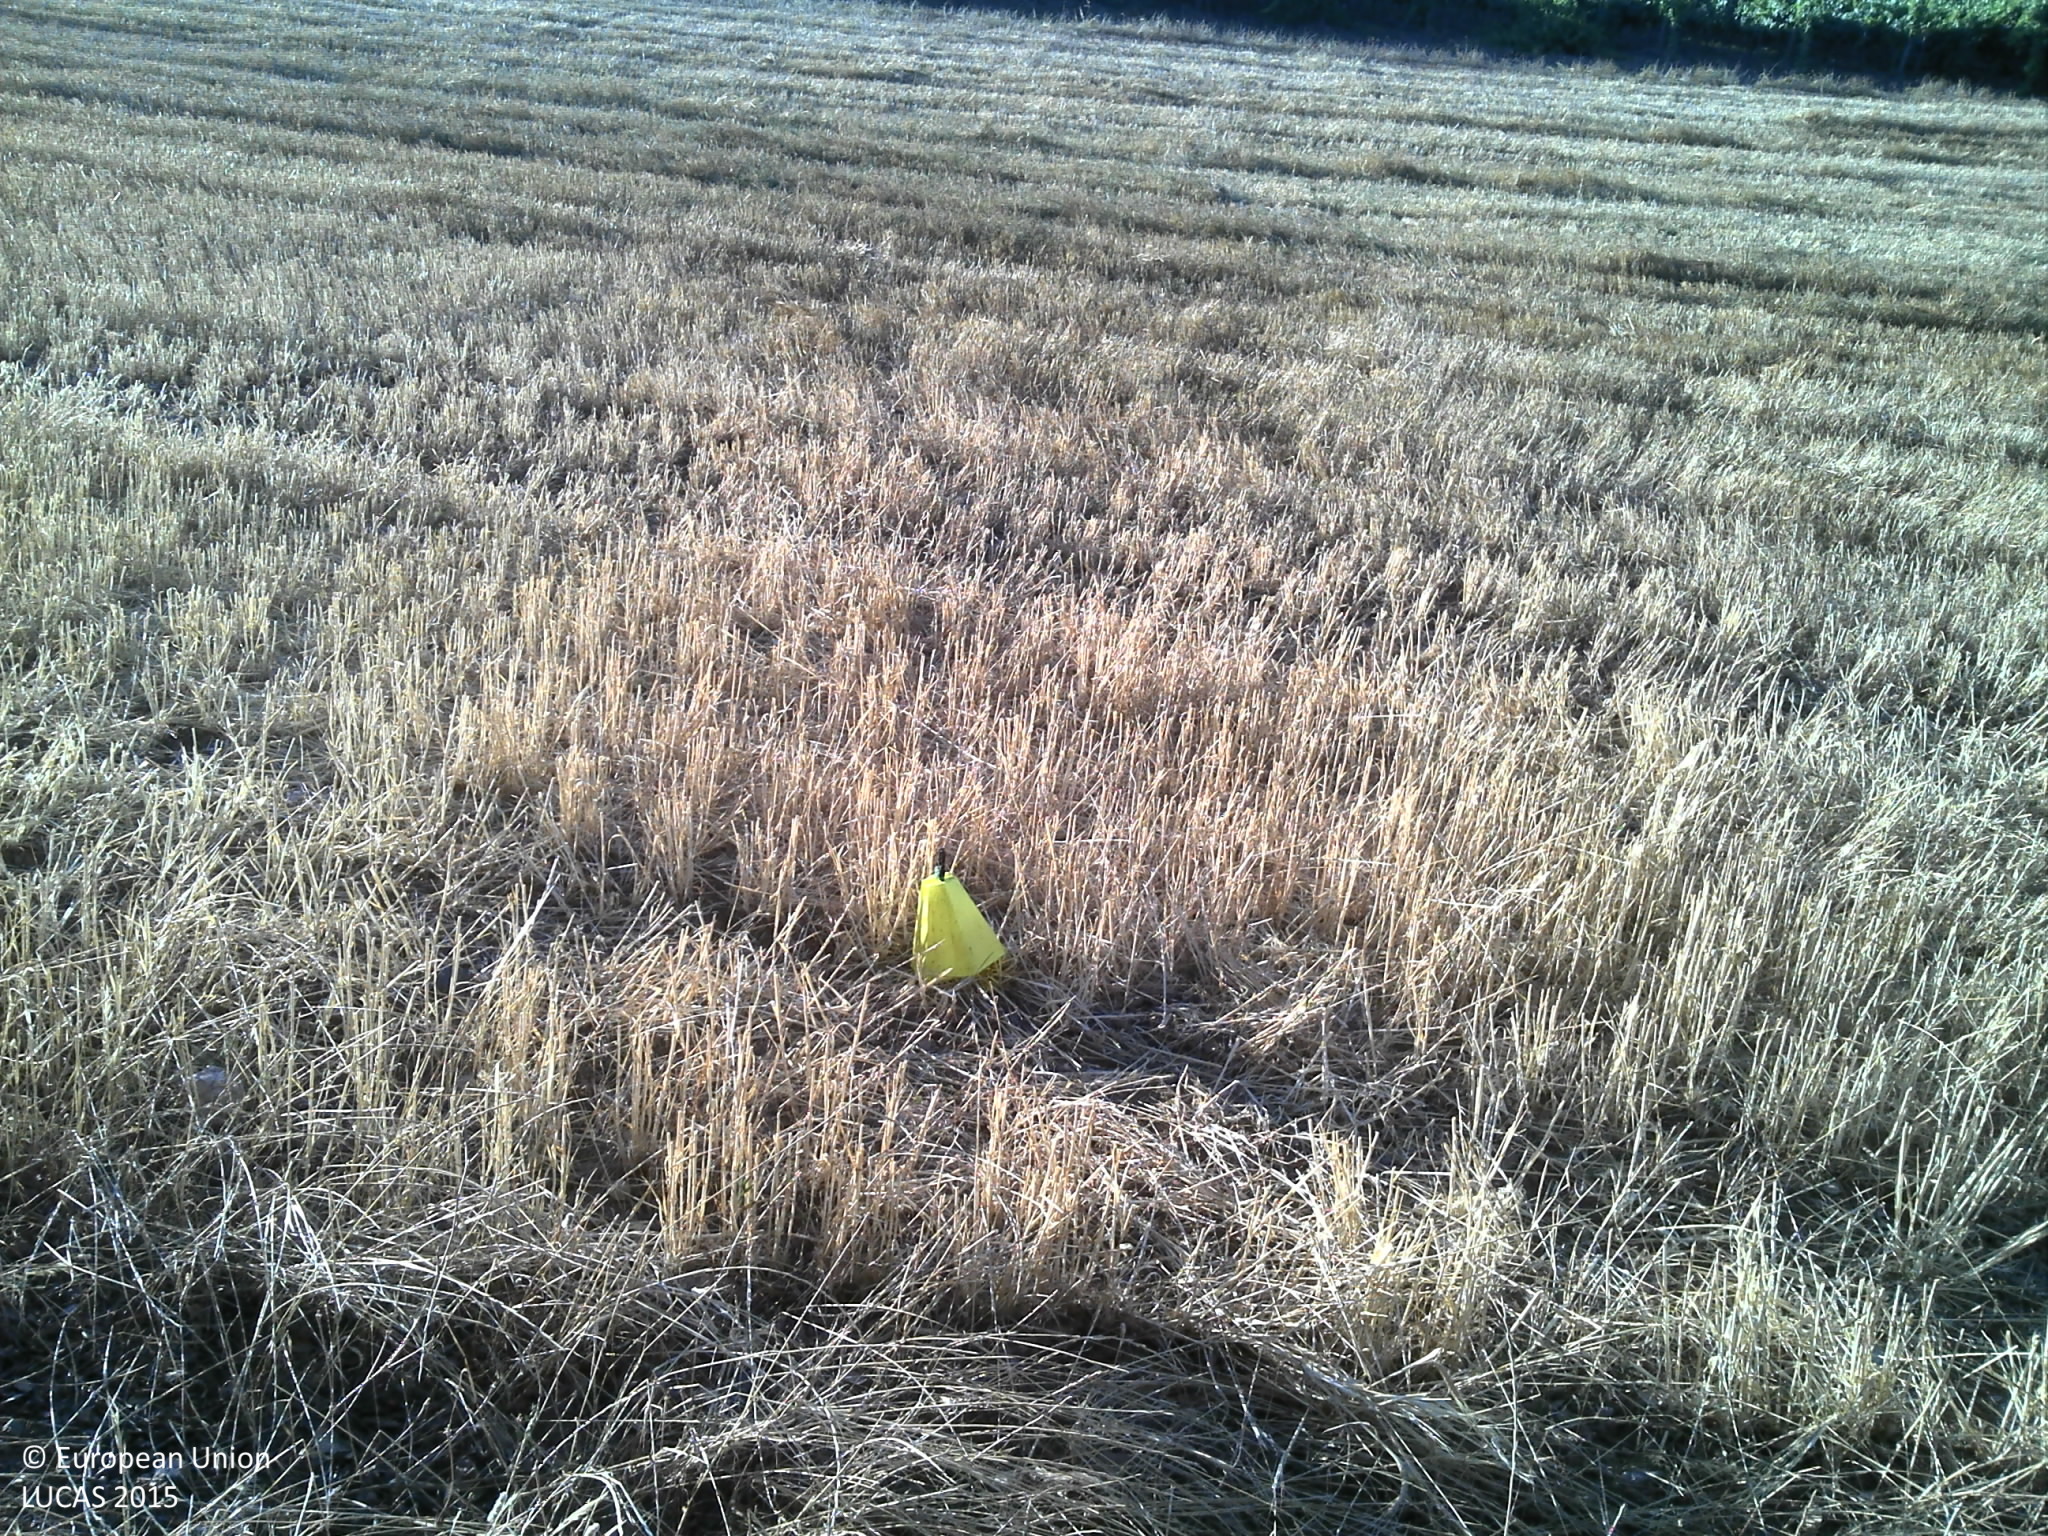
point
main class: Cropland
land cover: Triticale
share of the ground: < 10 %
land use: Agriculture (excluding fallow land and kitchen gardens)
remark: Harvested field
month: July
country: PT
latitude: 38.8712
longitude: -7.5678
